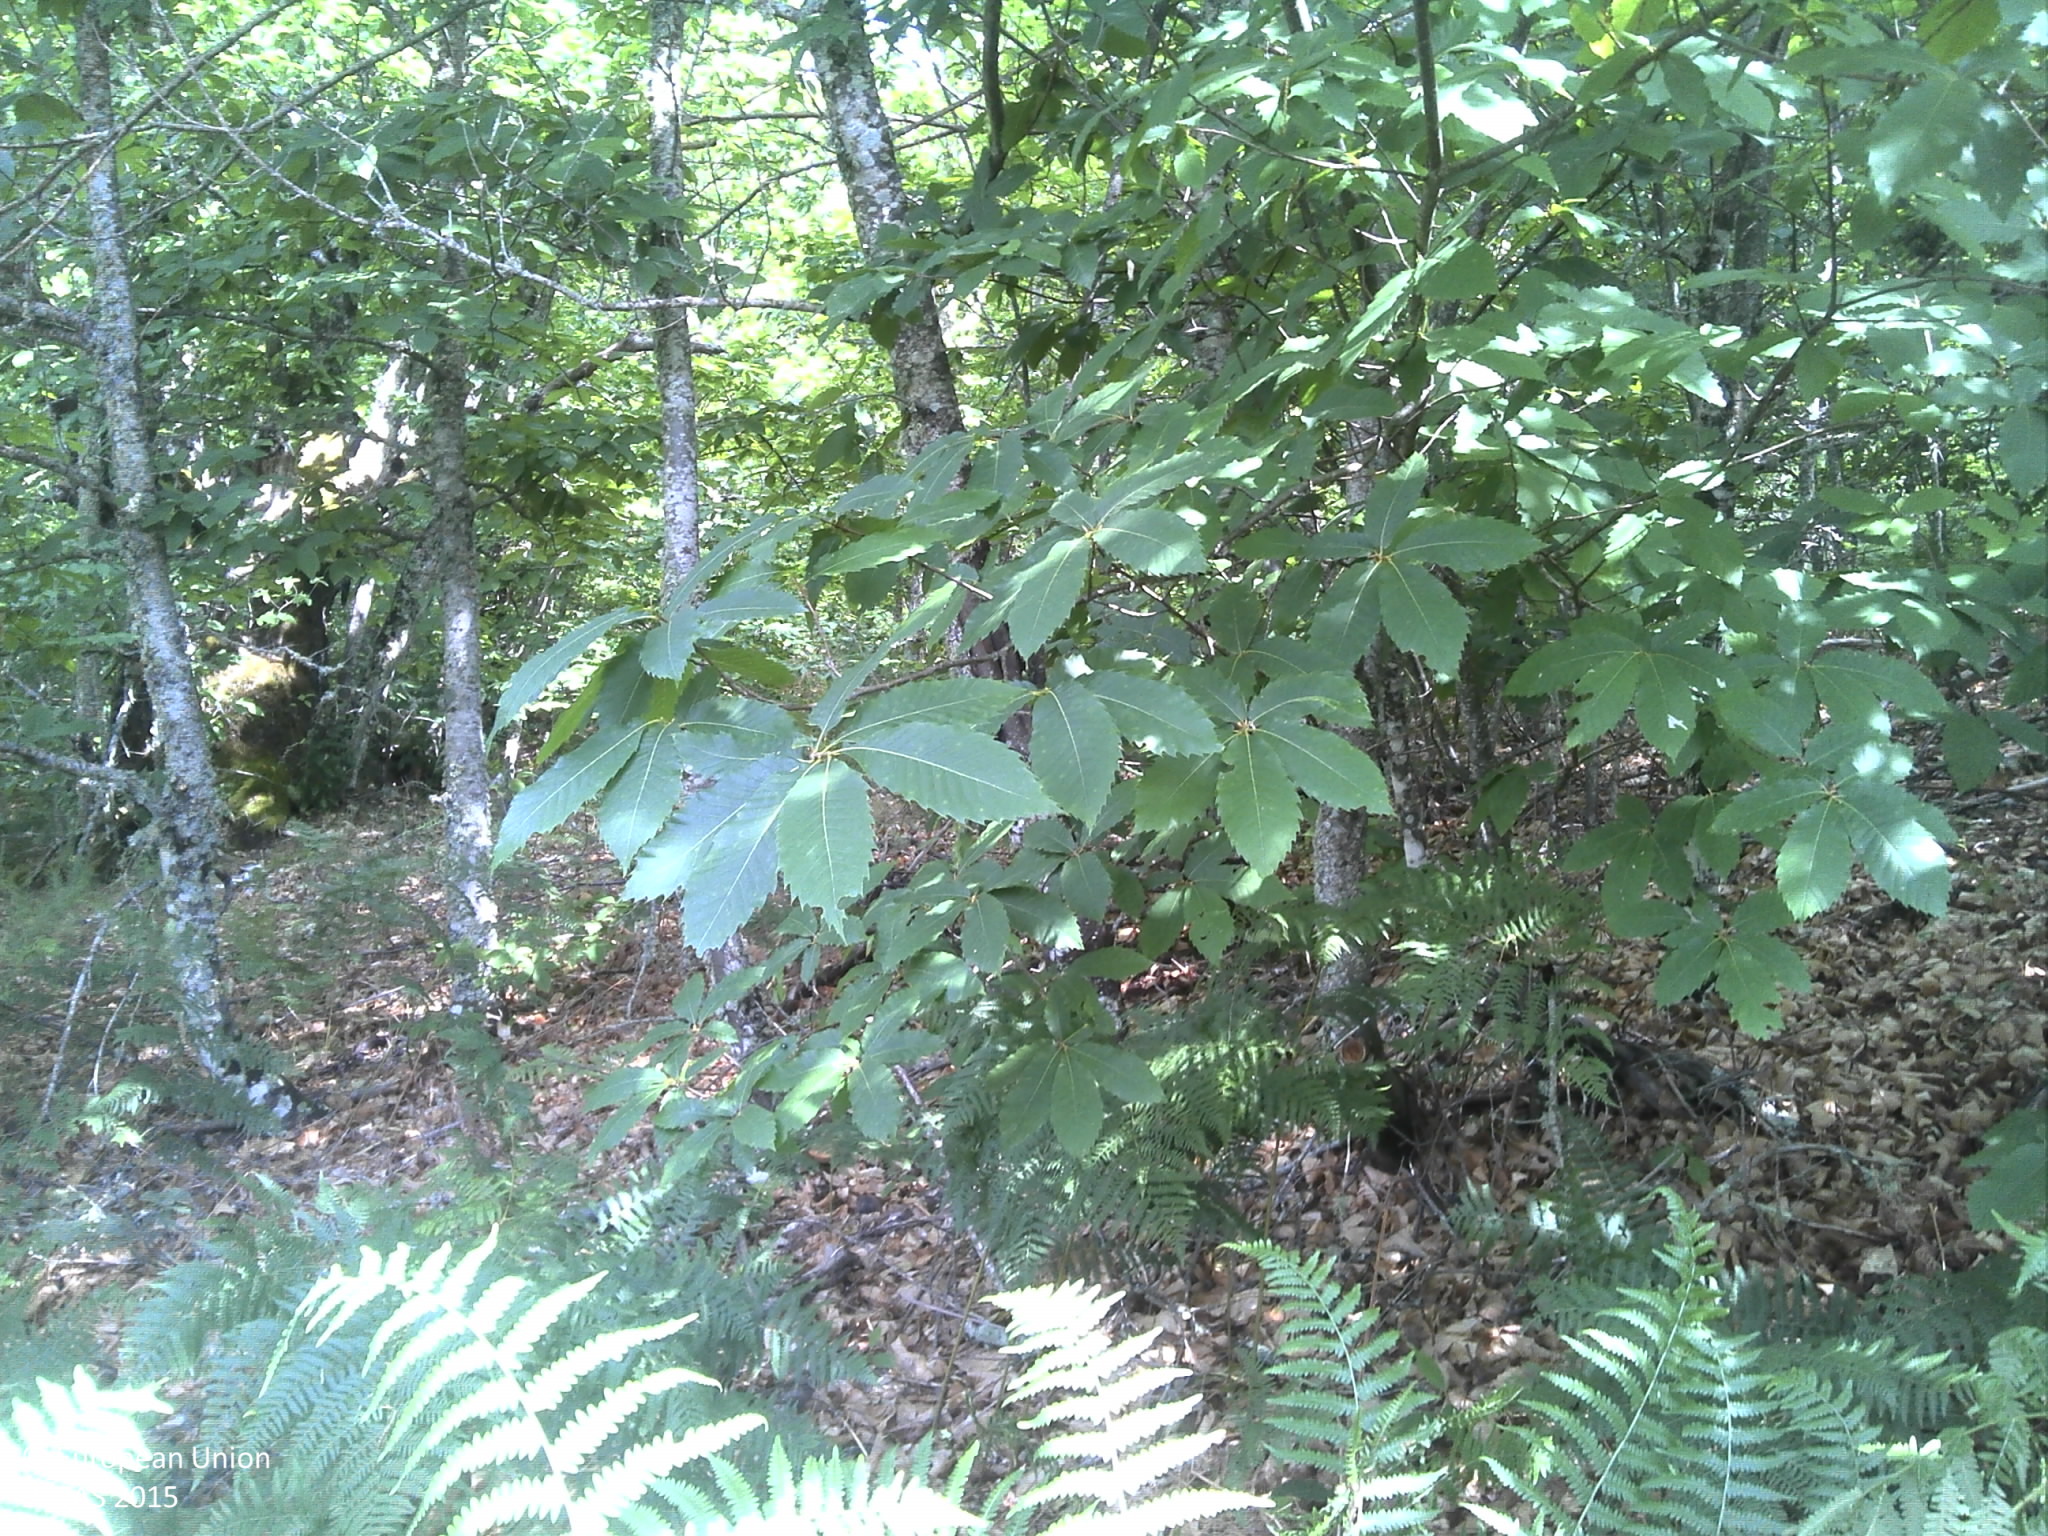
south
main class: Woodland
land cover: Pine dominated mixed woodland
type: coniferous forest of the mediterranean region
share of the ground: 50 - 75 %
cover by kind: coniferous forest trees 50 %, broadleaved forest trees 25 %, shrubs 20 %
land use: Forestry
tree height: > 5 m
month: June
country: PT
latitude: 40.2237
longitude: -7.4385
